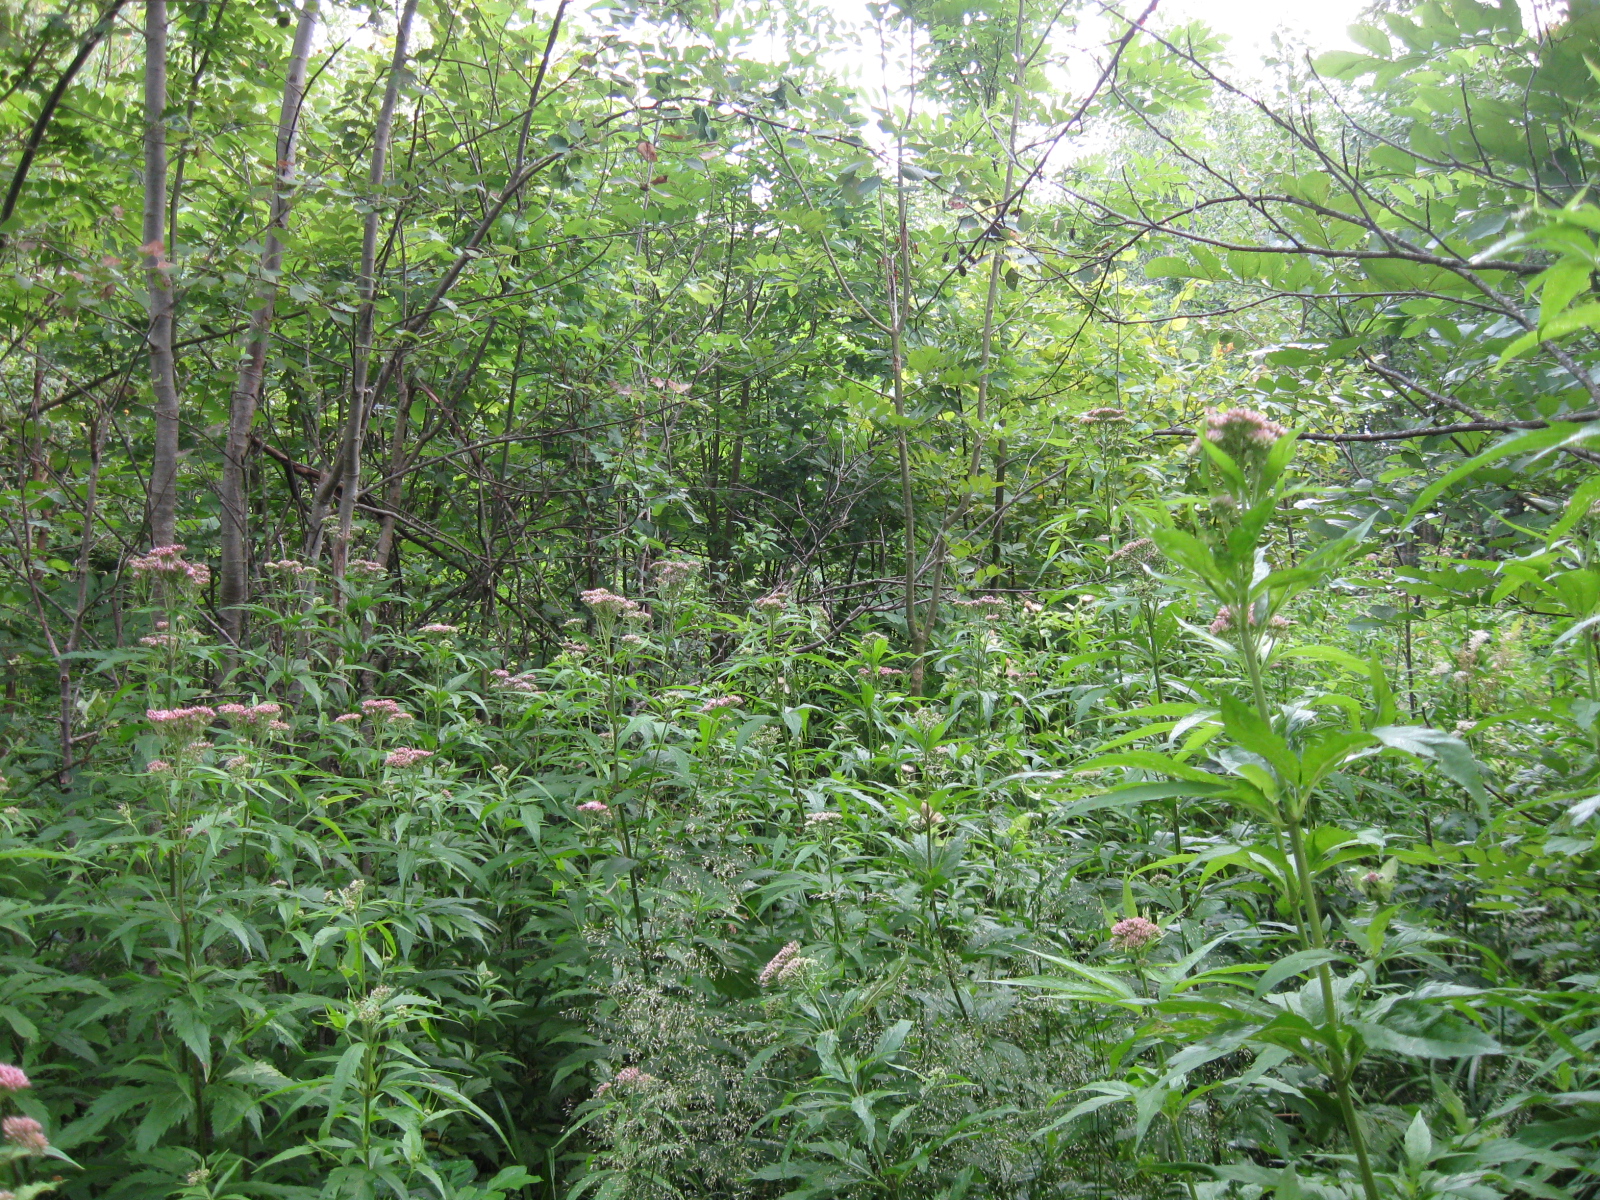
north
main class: Woodland
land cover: Broadleaved woodland
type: mire and swamp forests
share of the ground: > 75 %
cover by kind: broadleaved forest trees 75 %, herbaceous plants 25 %
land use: Forestry
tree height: > 5 m
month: July
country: LT
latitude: 54.4528
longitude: 23.4534
